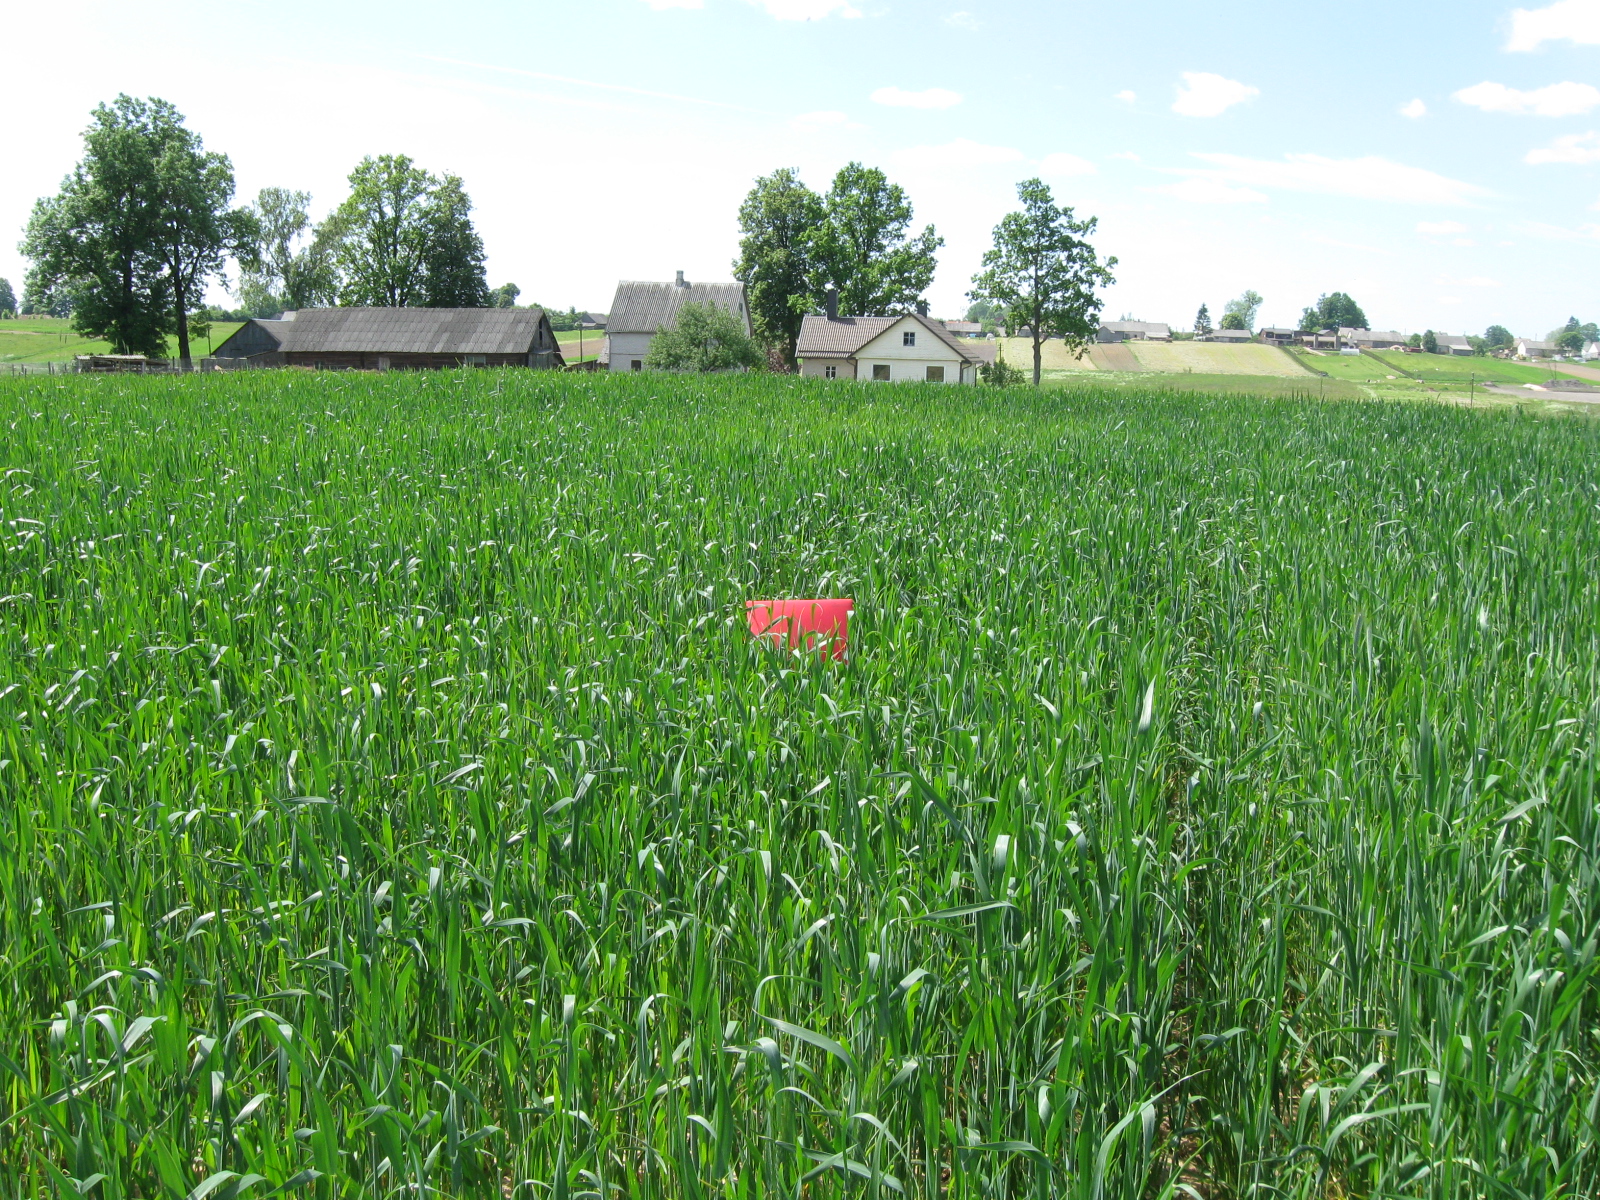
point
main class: Cropland
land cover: Common wheat
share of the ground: > 75 %
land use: Agriculture (excluding fallow land and kitchen gardens)
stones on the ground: < 10 %
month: June
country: LT
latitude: 54.5916
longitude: 23.8469
